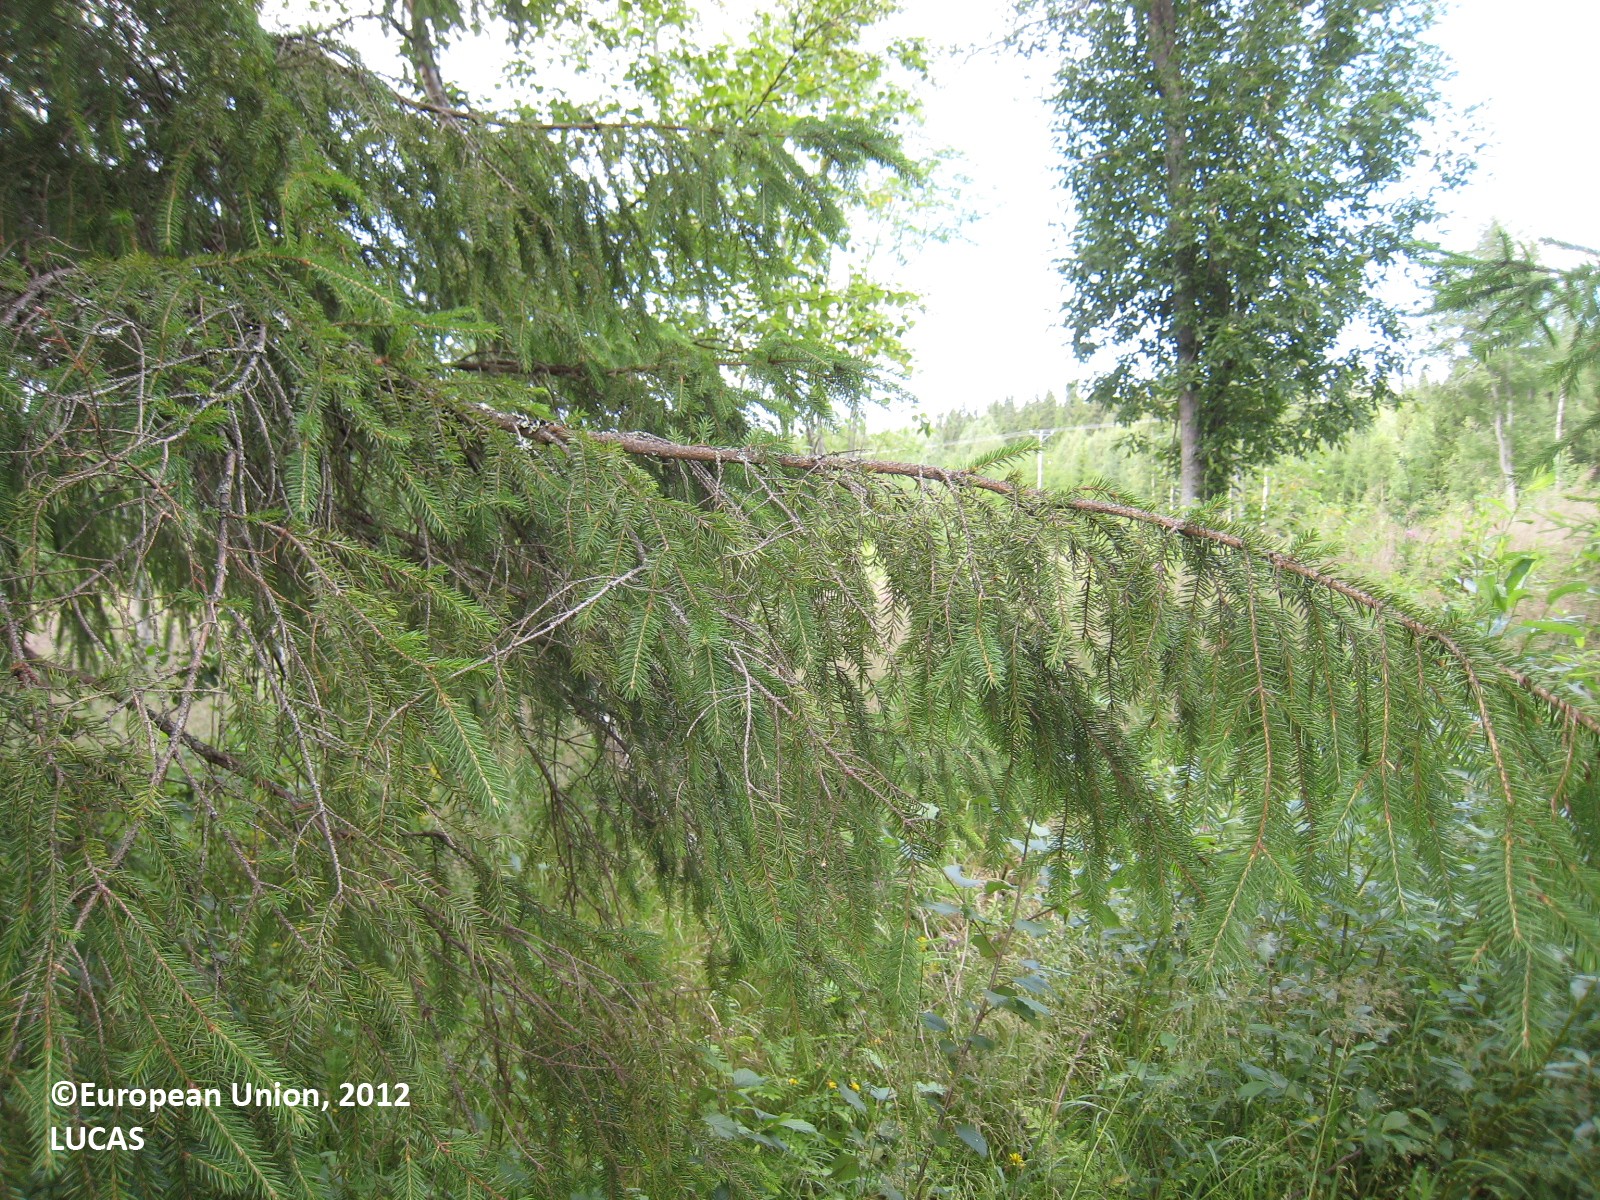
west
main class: Woodland
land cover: Spruce dominated mixed woodland
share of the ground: 25 - 50 %
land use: Forestry
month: July
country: FI
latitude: 62.8501
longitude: 27.3868
